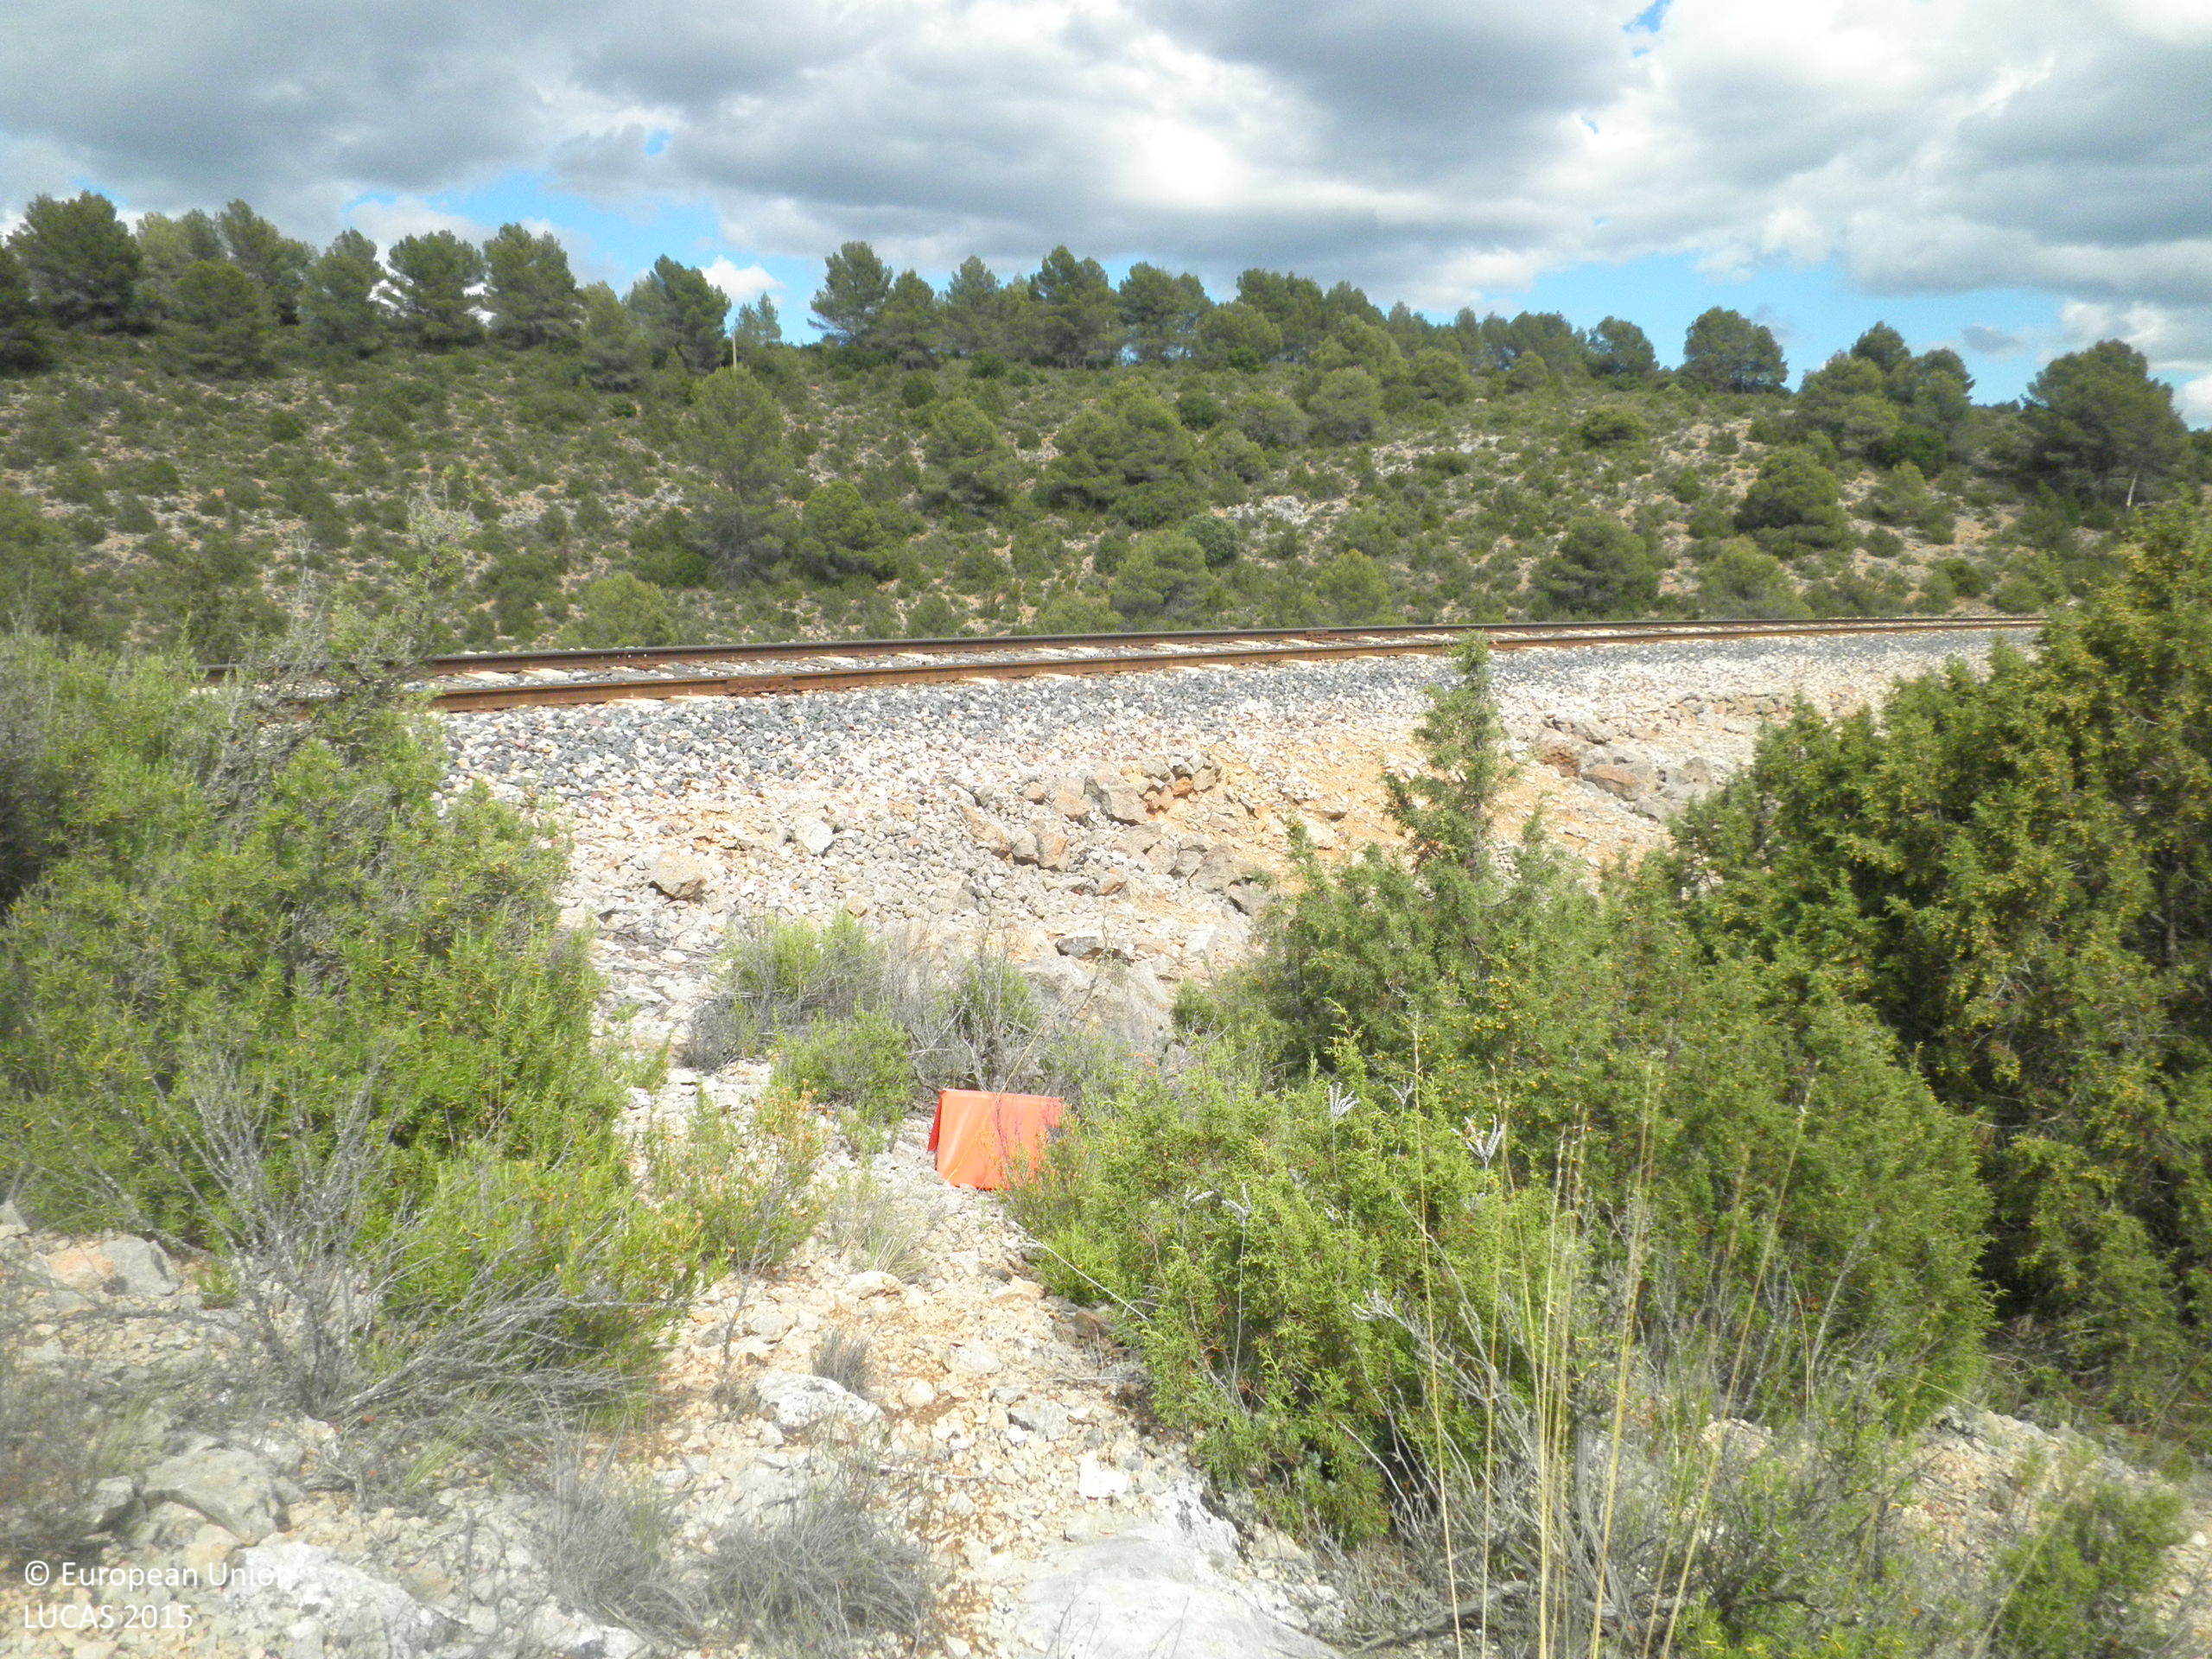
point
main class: Shrubland
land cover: Shrubland without tree cover
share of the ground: 25 - 50 %
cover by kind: unconsolidated bare surface 60 %, shrubs 30 %, herbaceous plants 10 %
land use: Semi-natural and natural areas not in use
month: June
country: ES
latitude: 39.7636
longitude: -1.7168
